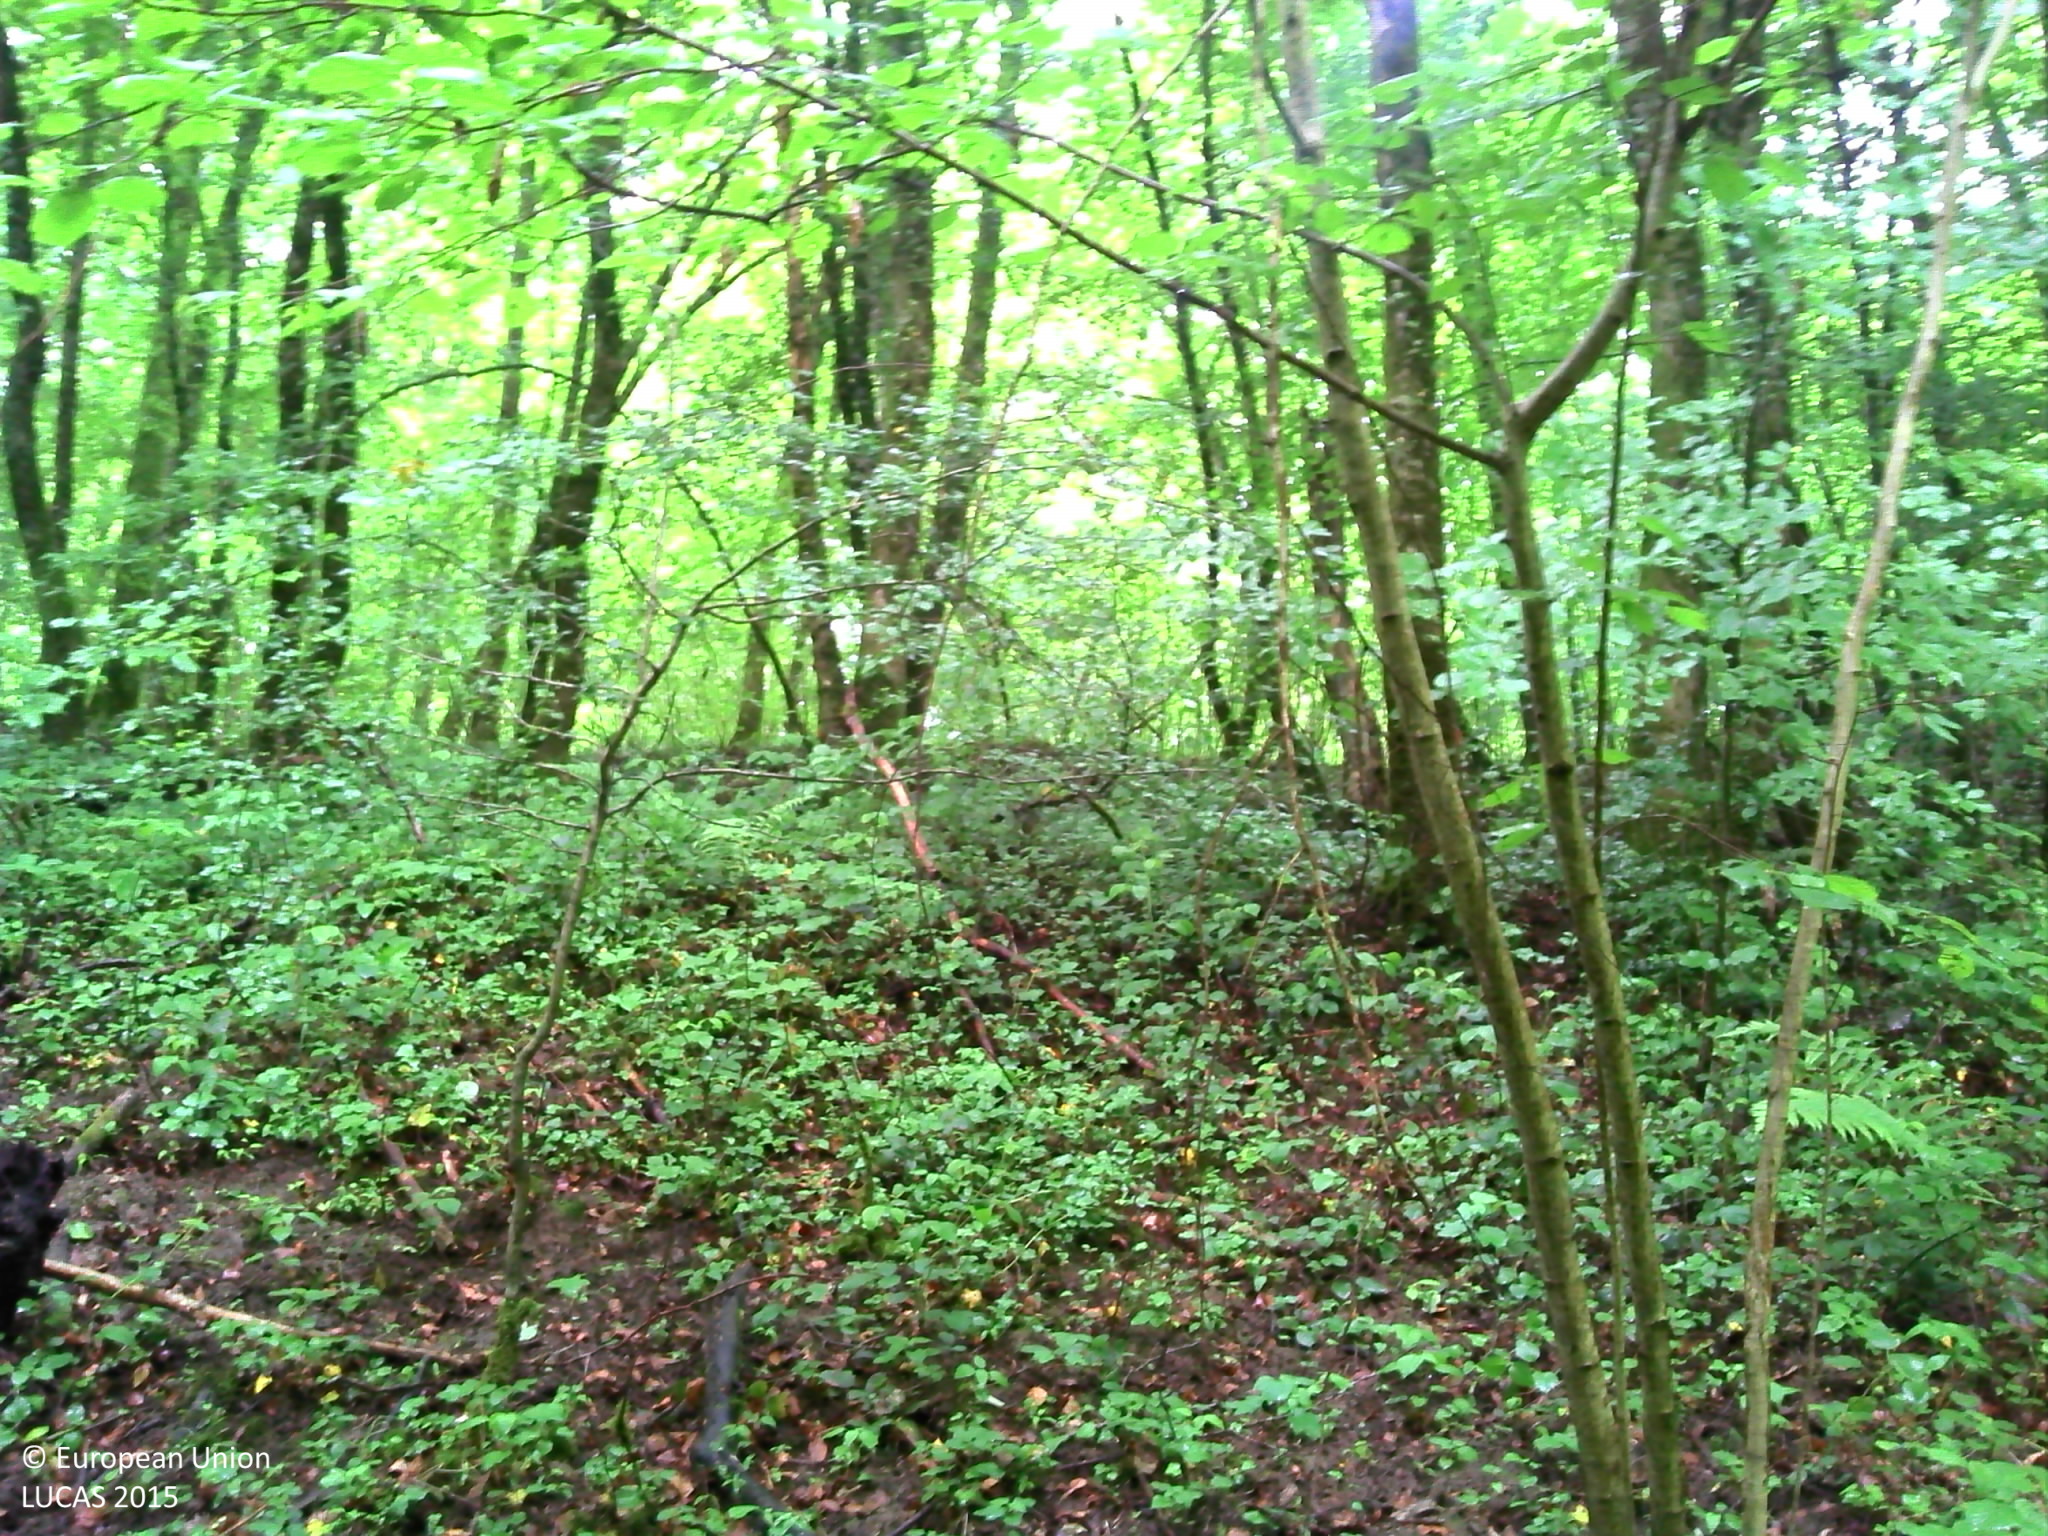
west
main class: Woodland
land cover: Broadleaved woodland
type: mesophytic deciduous forest
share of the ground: > 75 %
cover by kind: broadleaved forest trees 85 %, herbaceous plants 10 %, coniferous forest trees 5 %
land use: Forestry
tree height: > 5 m
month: May
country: FR
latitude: 48.6146
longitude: 4.9930
